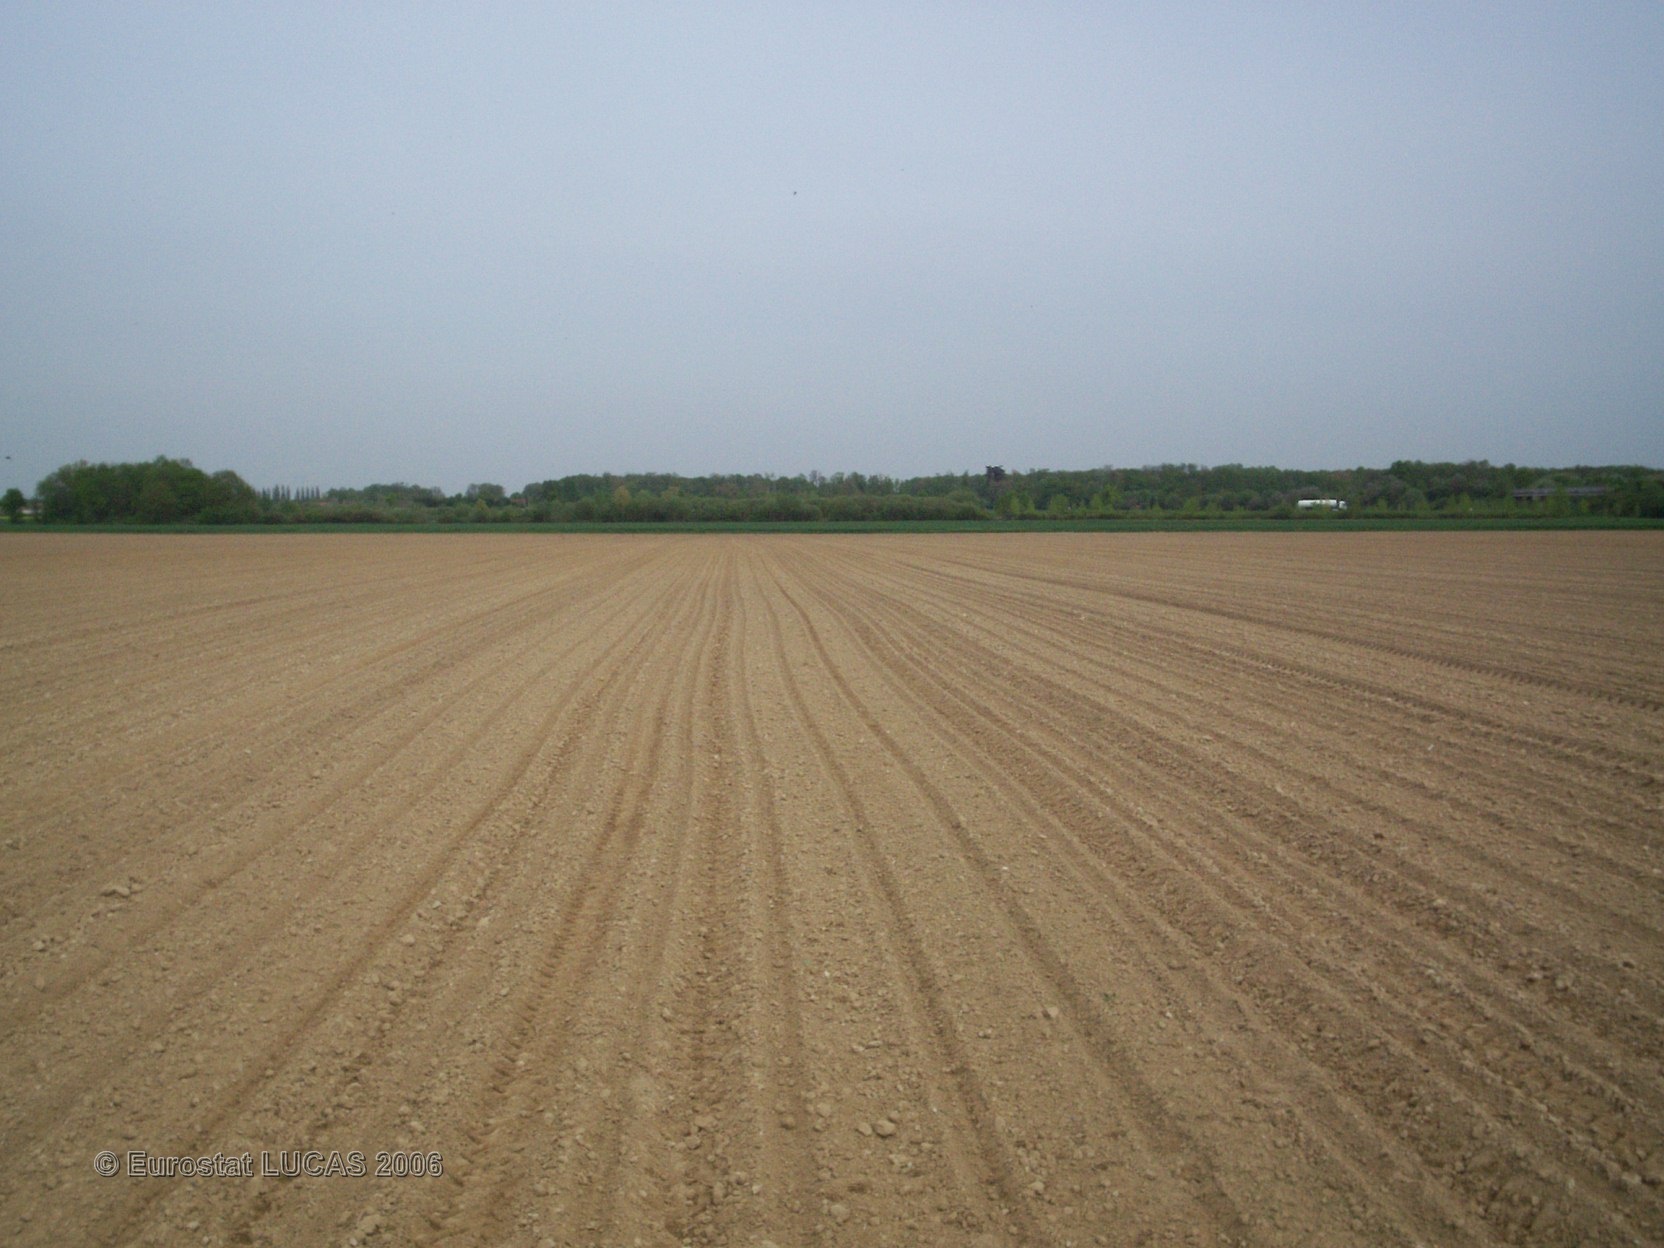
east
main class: Cropland
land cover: Sugar beet
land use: Agriculture (excluding fallow land and kitchen gardens)
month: May
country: FR
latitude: 48.7499
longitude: 2.8503
